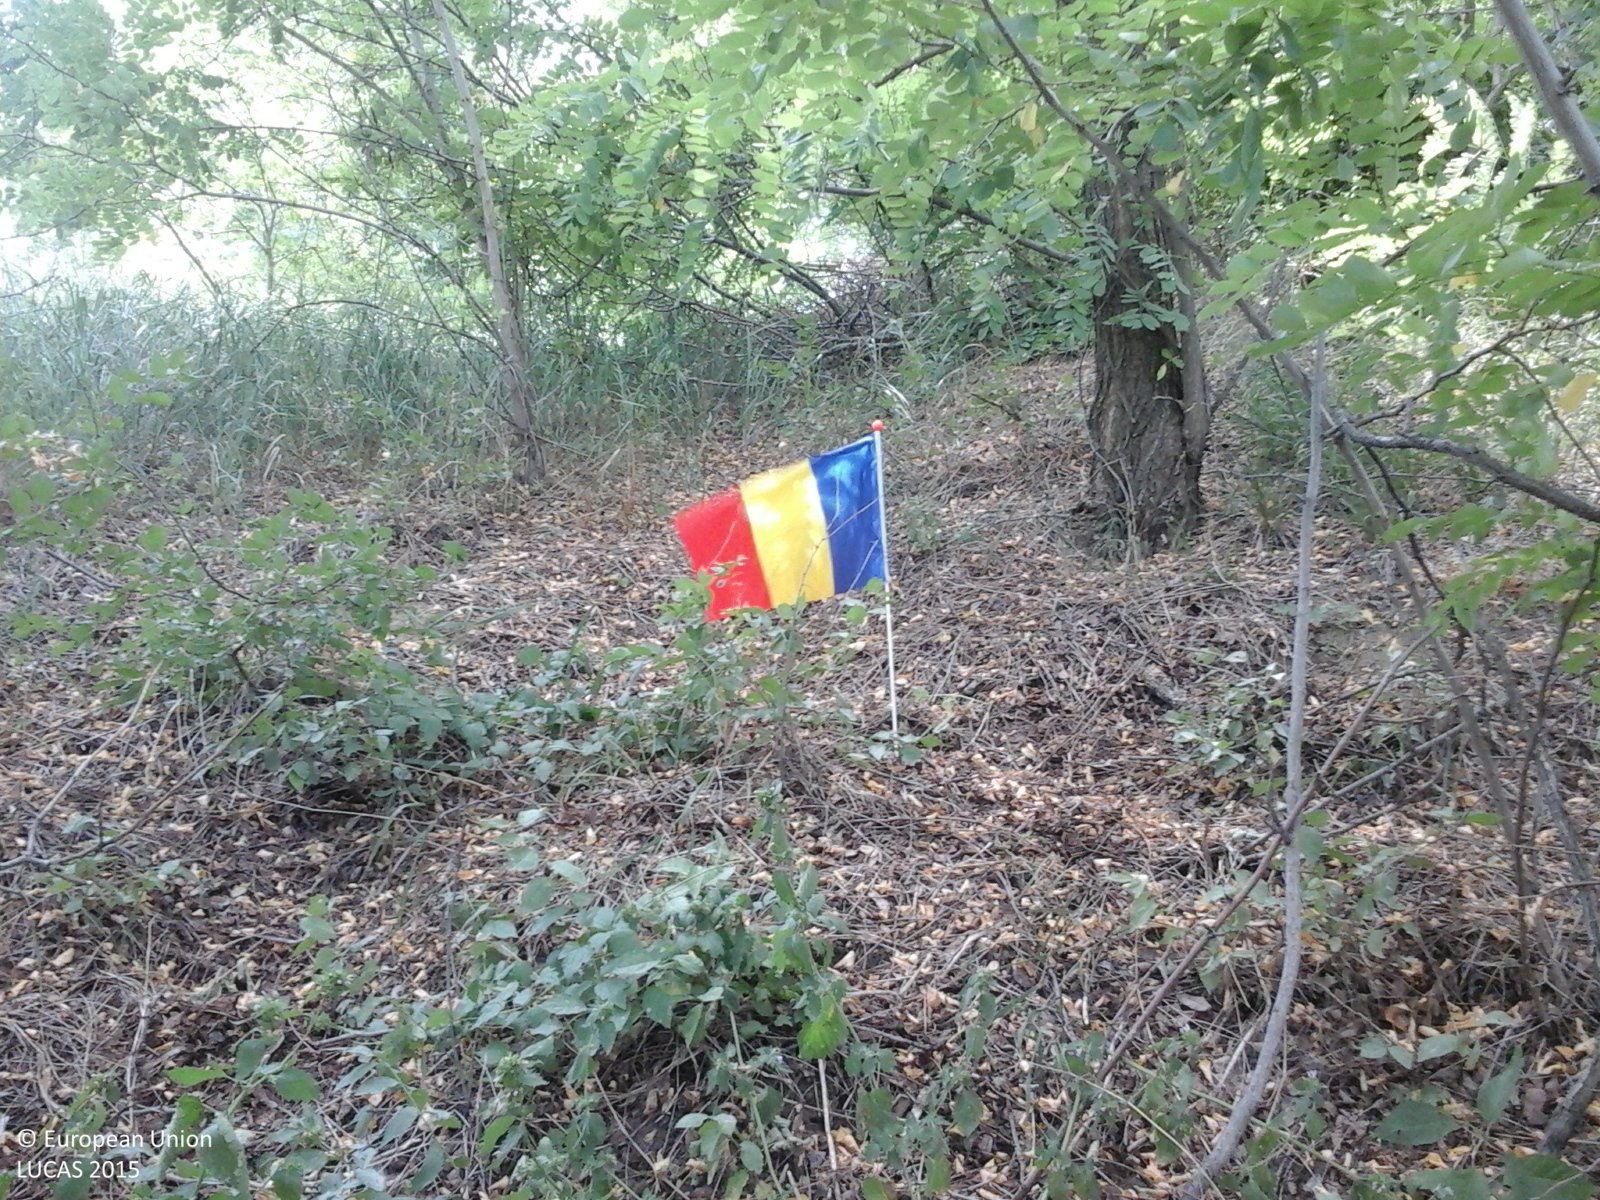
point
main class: Woodland
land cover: Broadleaved woodland
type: exotic forest
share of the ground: > 75 %
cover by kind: broadleaved forest trees 100 %
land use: Forestry
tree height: > 5 m
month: July
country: RO
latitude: 46.5894
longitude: 27.2673
